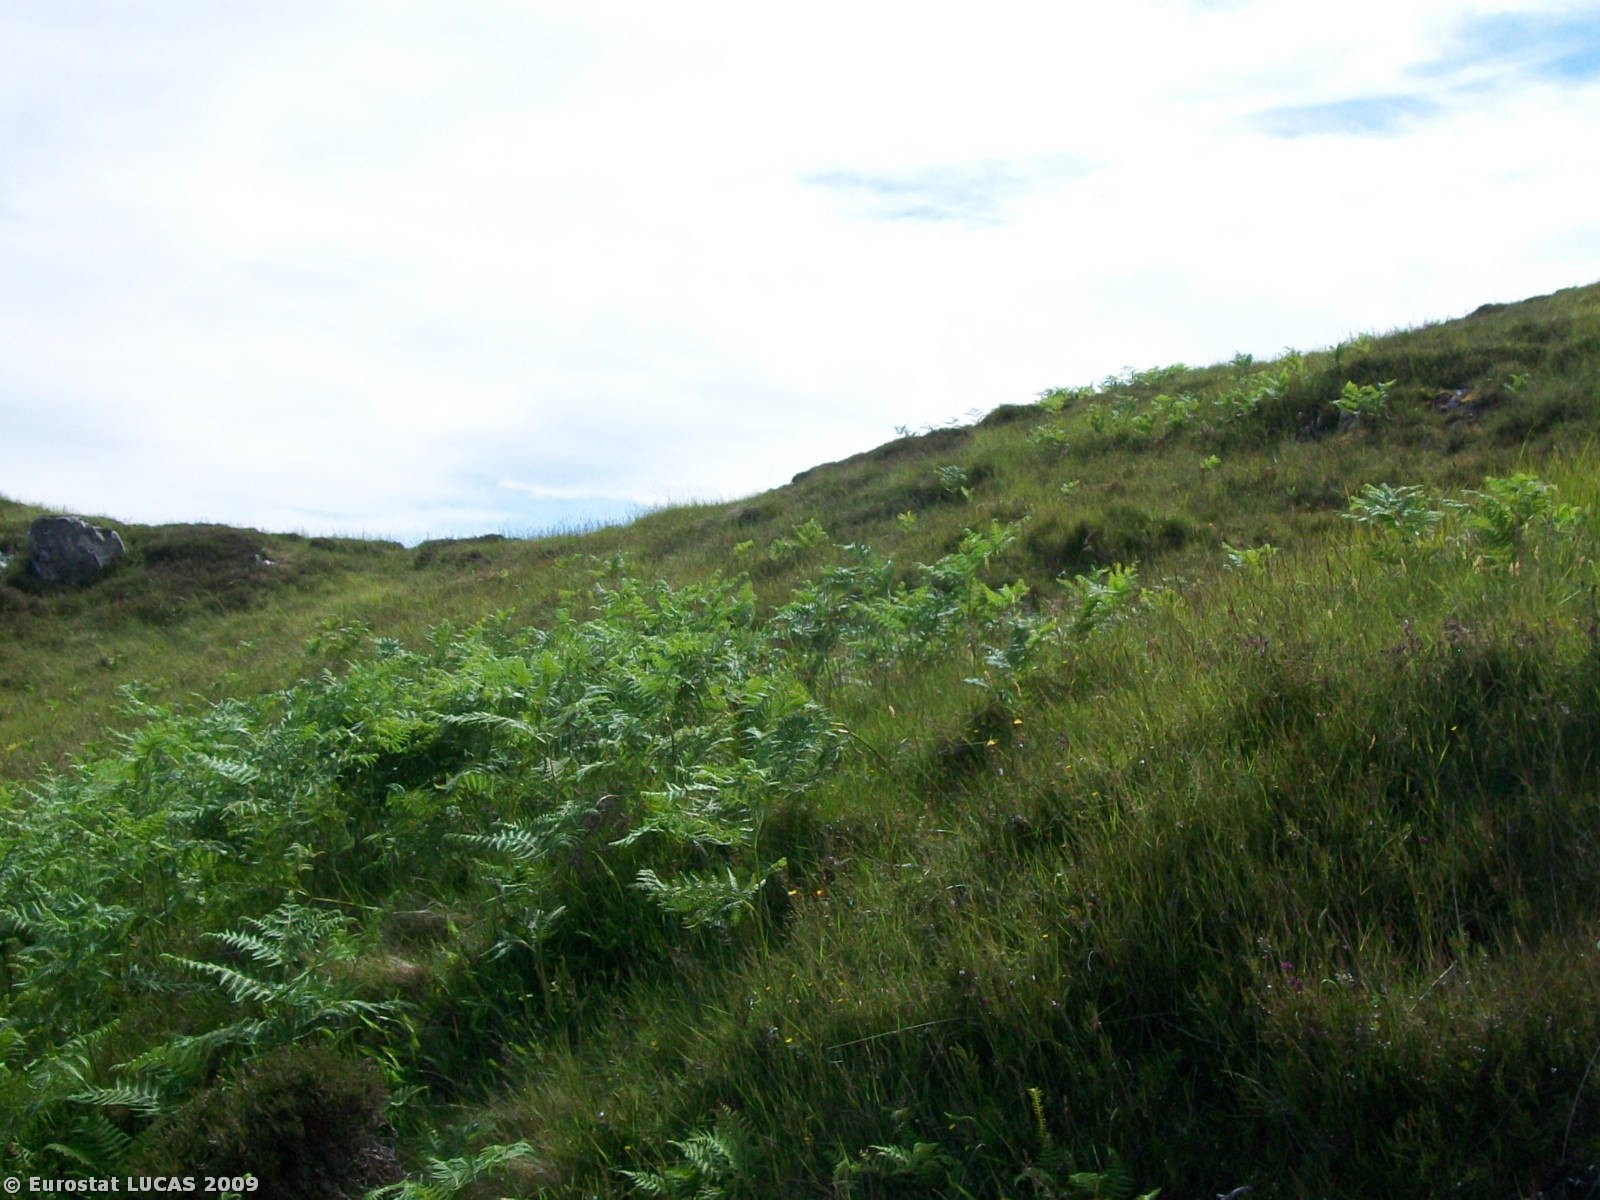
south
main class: Shrubland
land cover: Shrubland without tree cover
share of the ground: > 75 %
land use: Unused
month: June
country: GB
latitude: 58.2416
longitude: -5.2476
